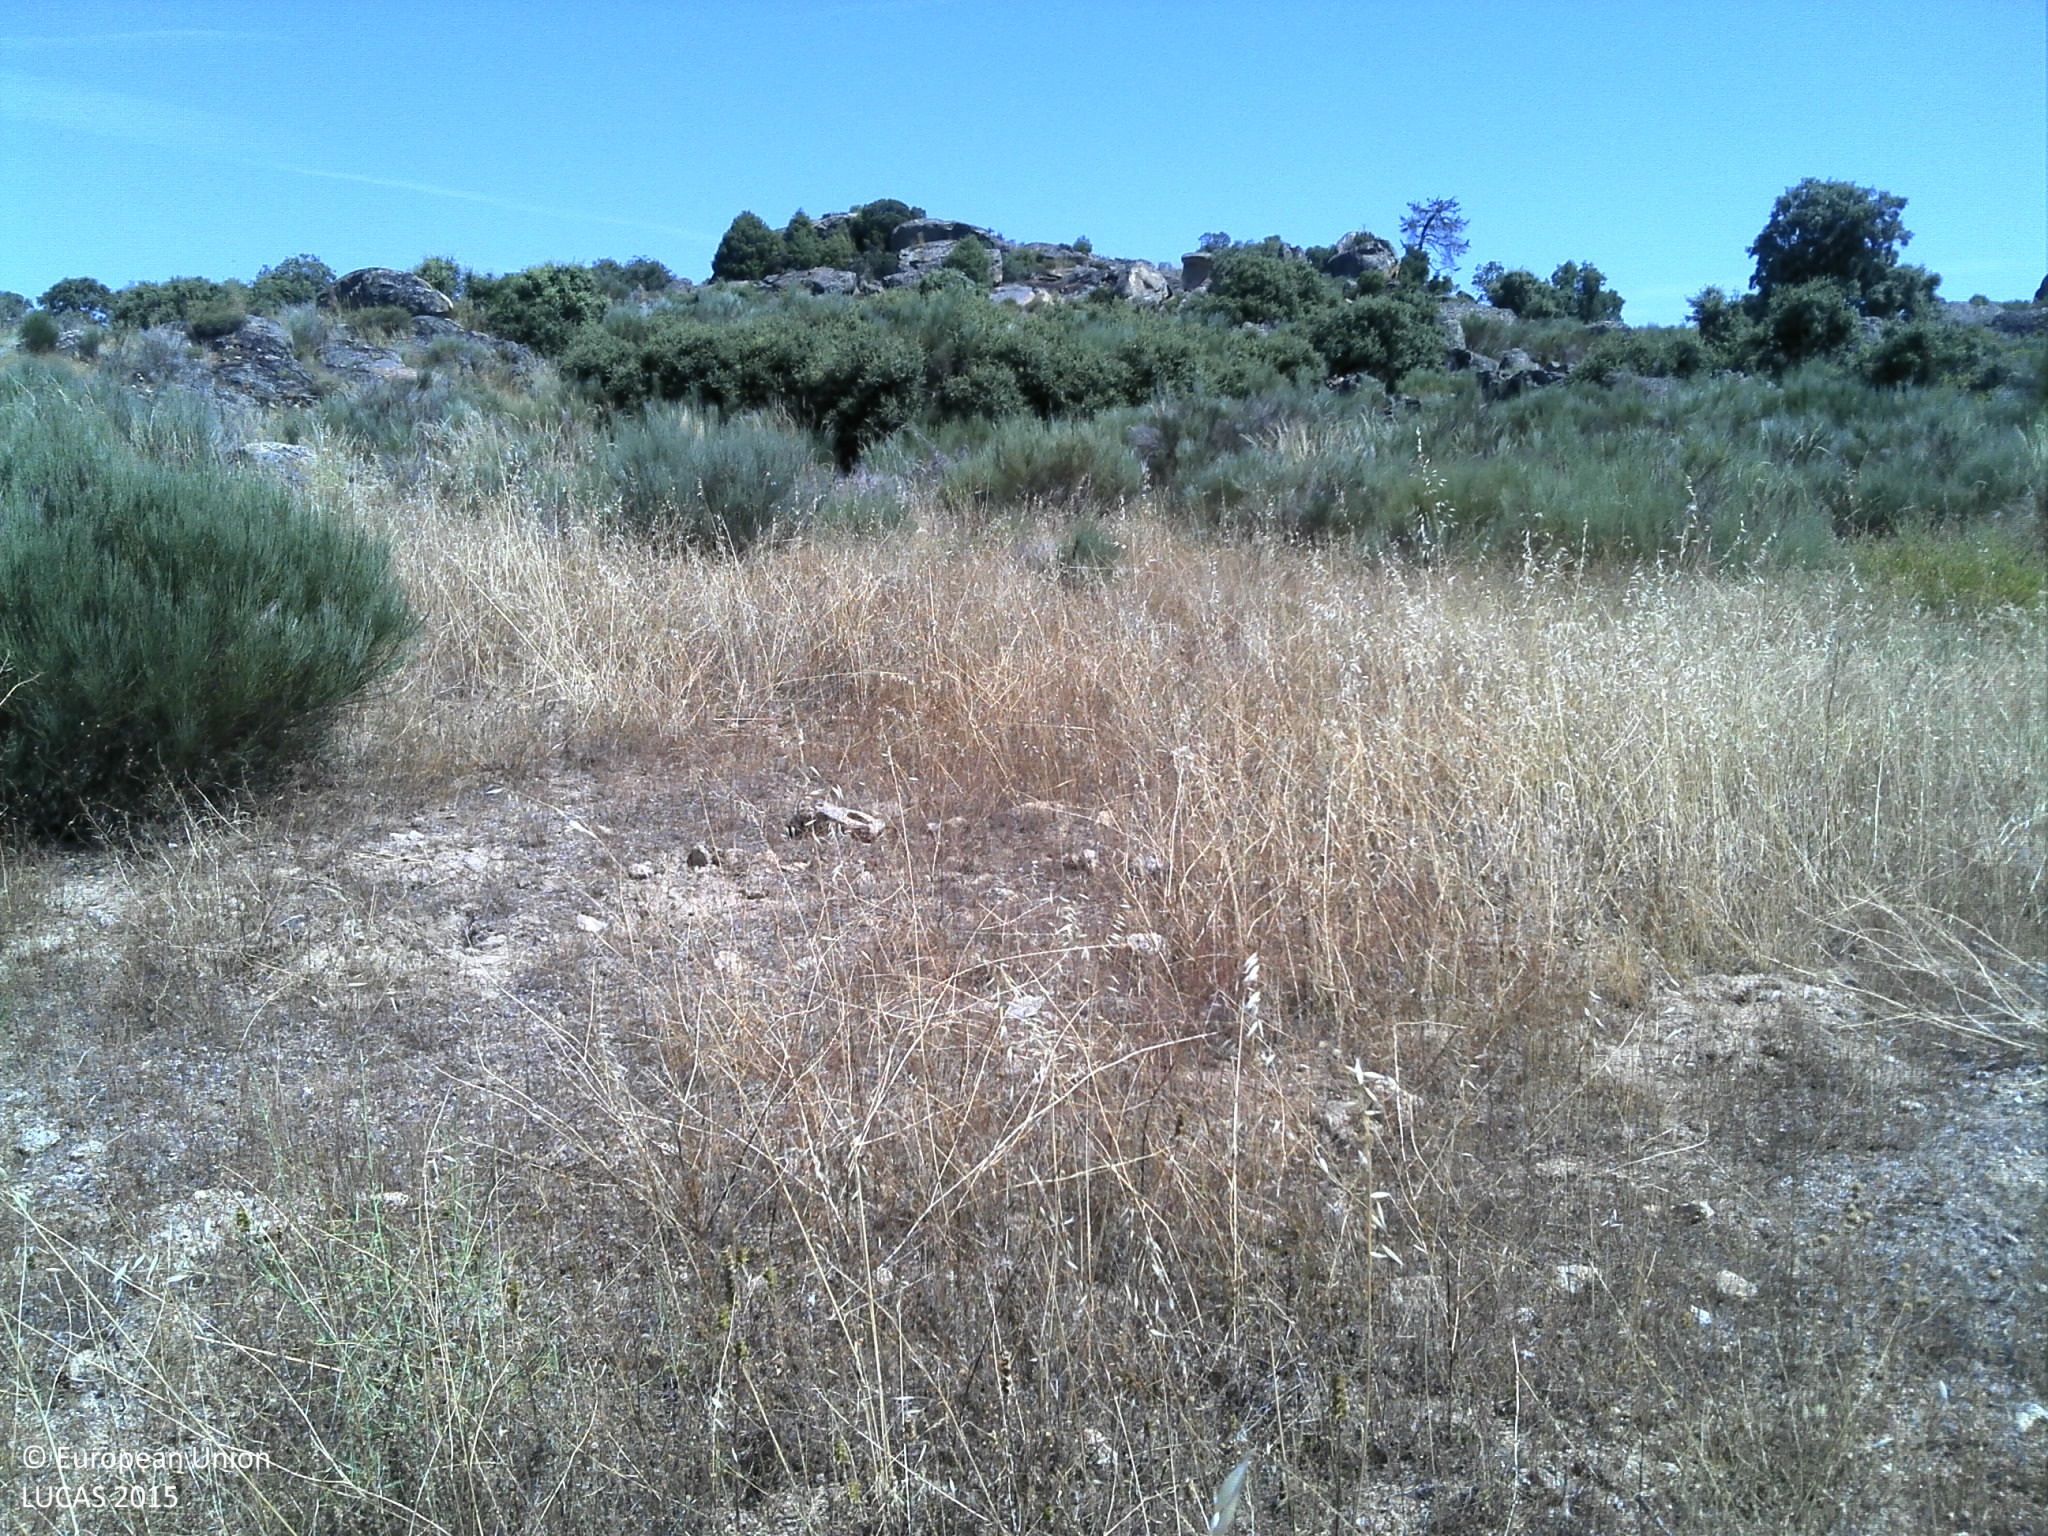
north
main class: Shrubland
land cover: Shrubland without tree cover
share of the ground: 25 - 50 %
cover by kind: herbaceous plants 40 %, shrubs 30 %, unconsolidated bare surface 30 %
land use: Fallow land
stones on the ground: < 10 %
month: June
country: PT
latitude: 40.9746
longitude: -6.9447
